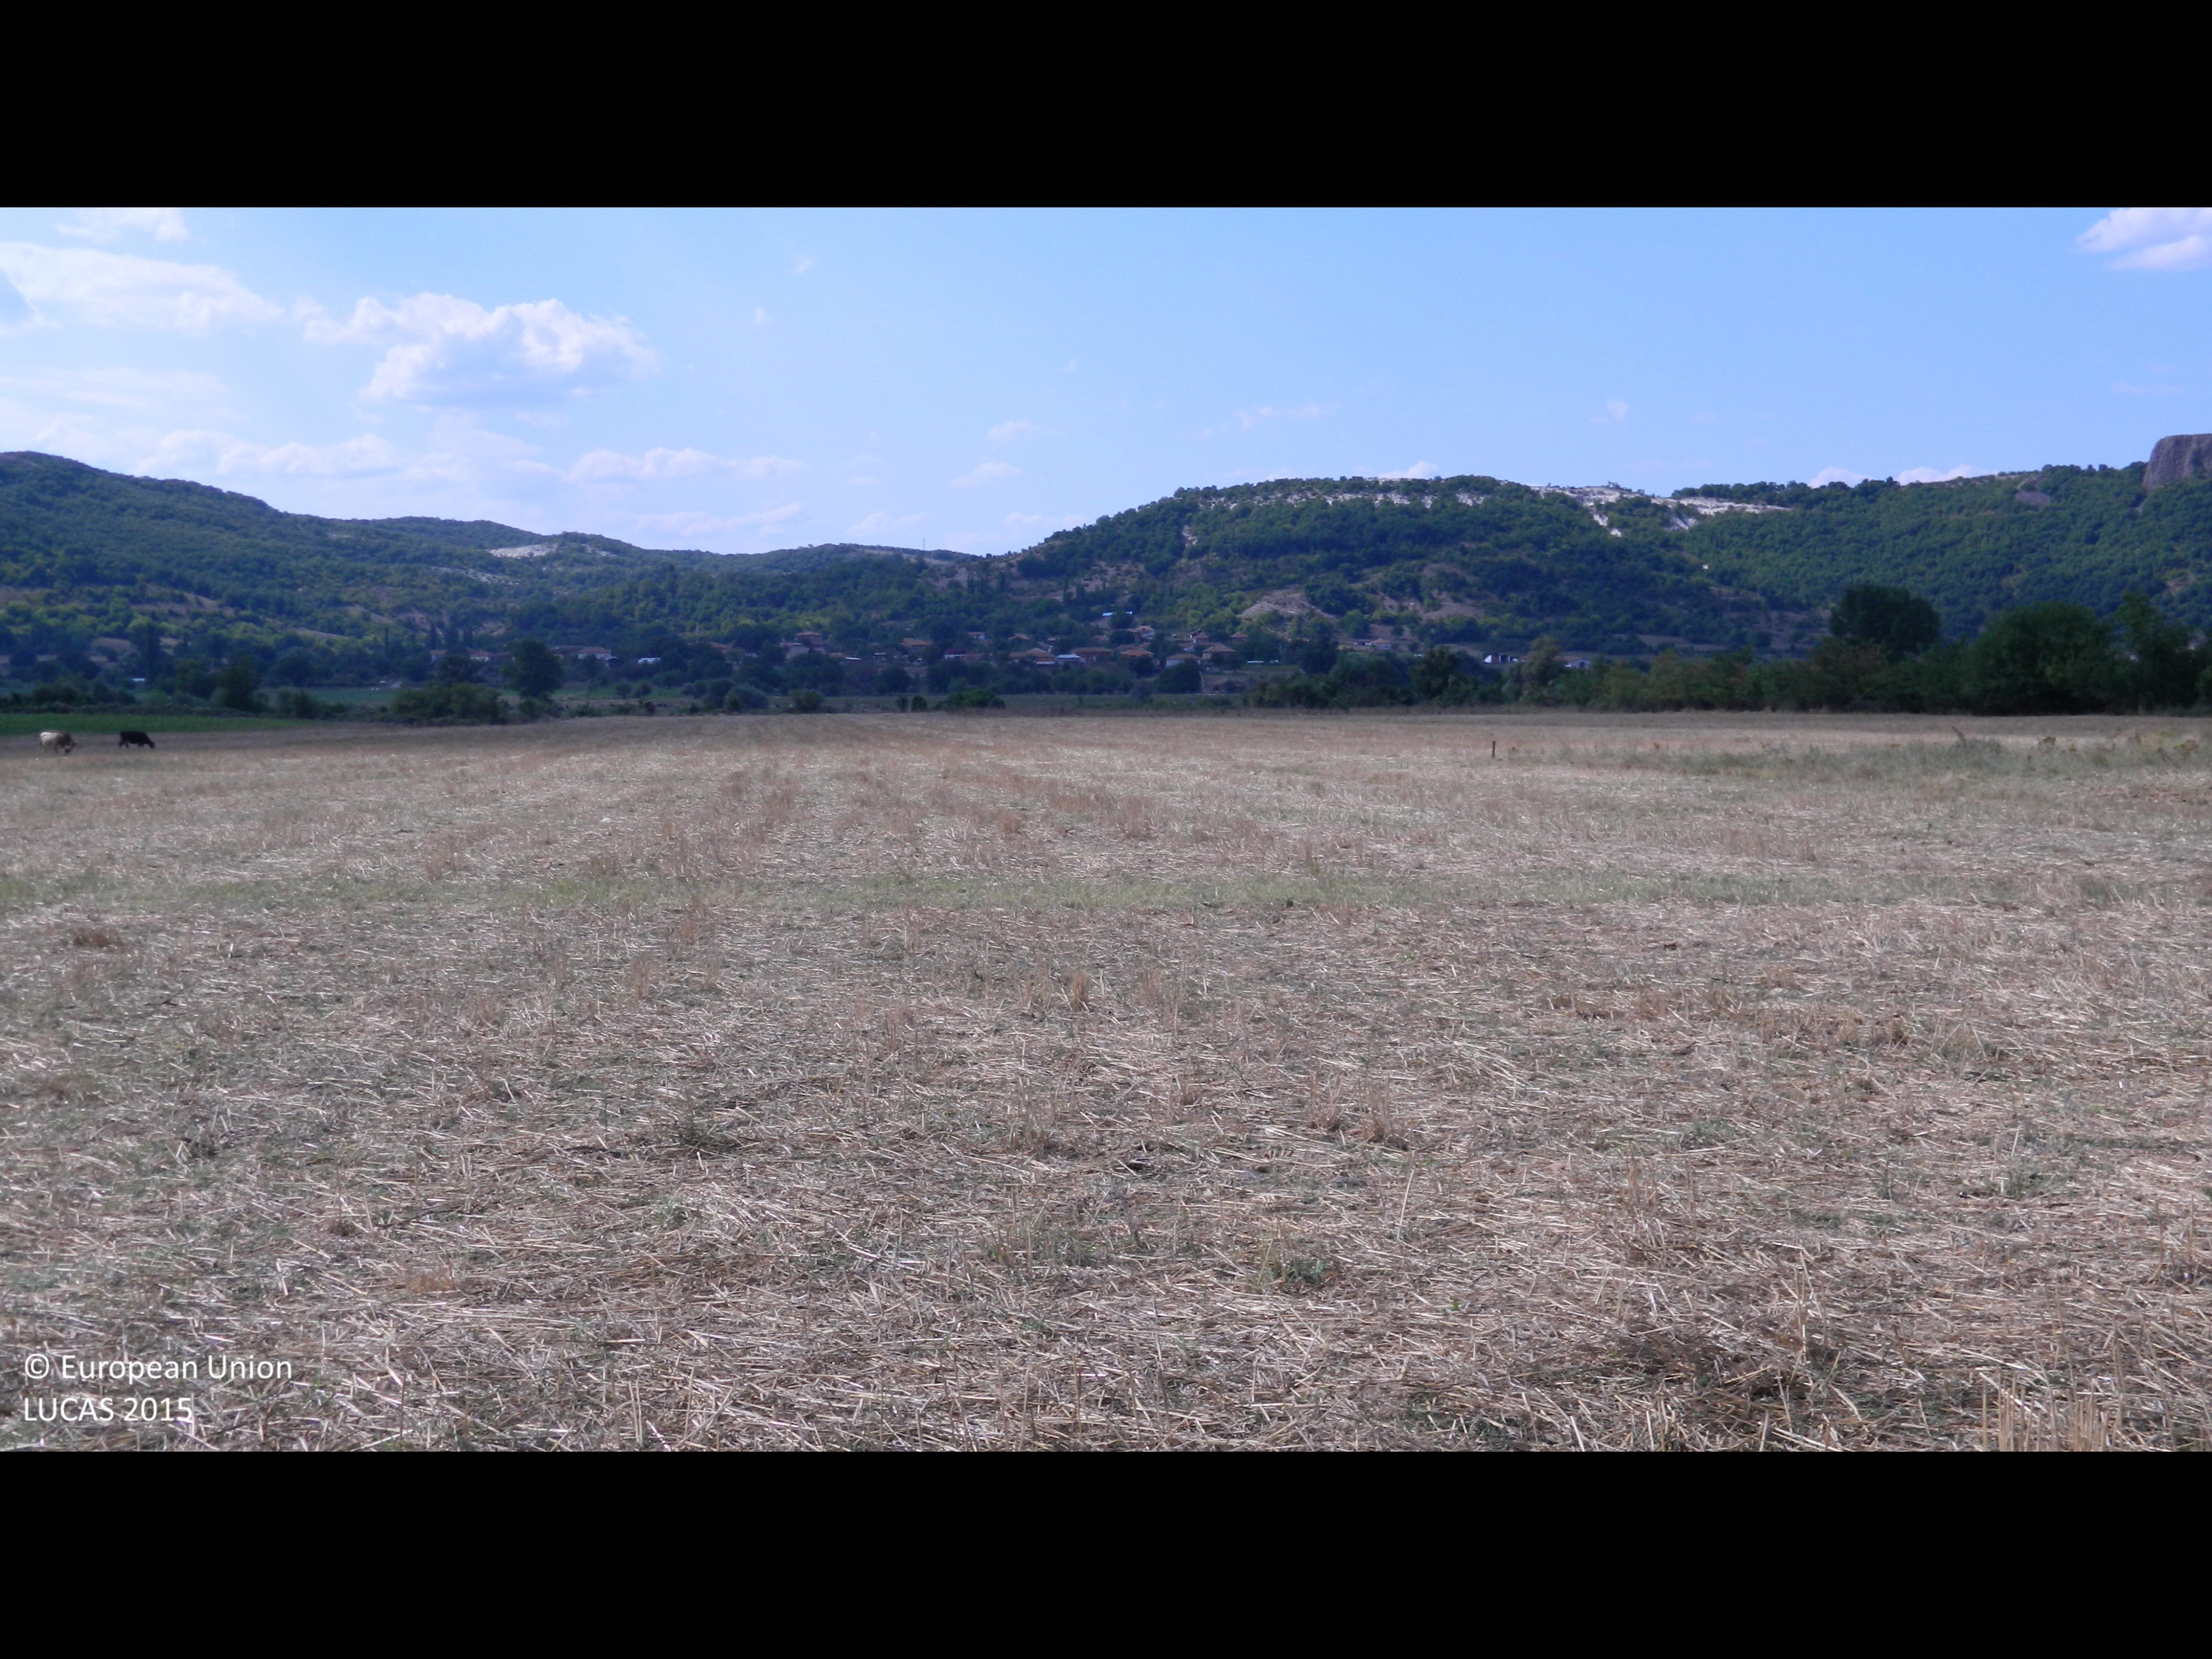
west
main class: Cropland
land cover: Common wheat
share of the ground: < 10 %
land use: Agriculture (excluding fallow land and kitchen gardens)
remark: Harvested field
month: August
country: BG
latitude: 41.6326
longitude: 25.7536
